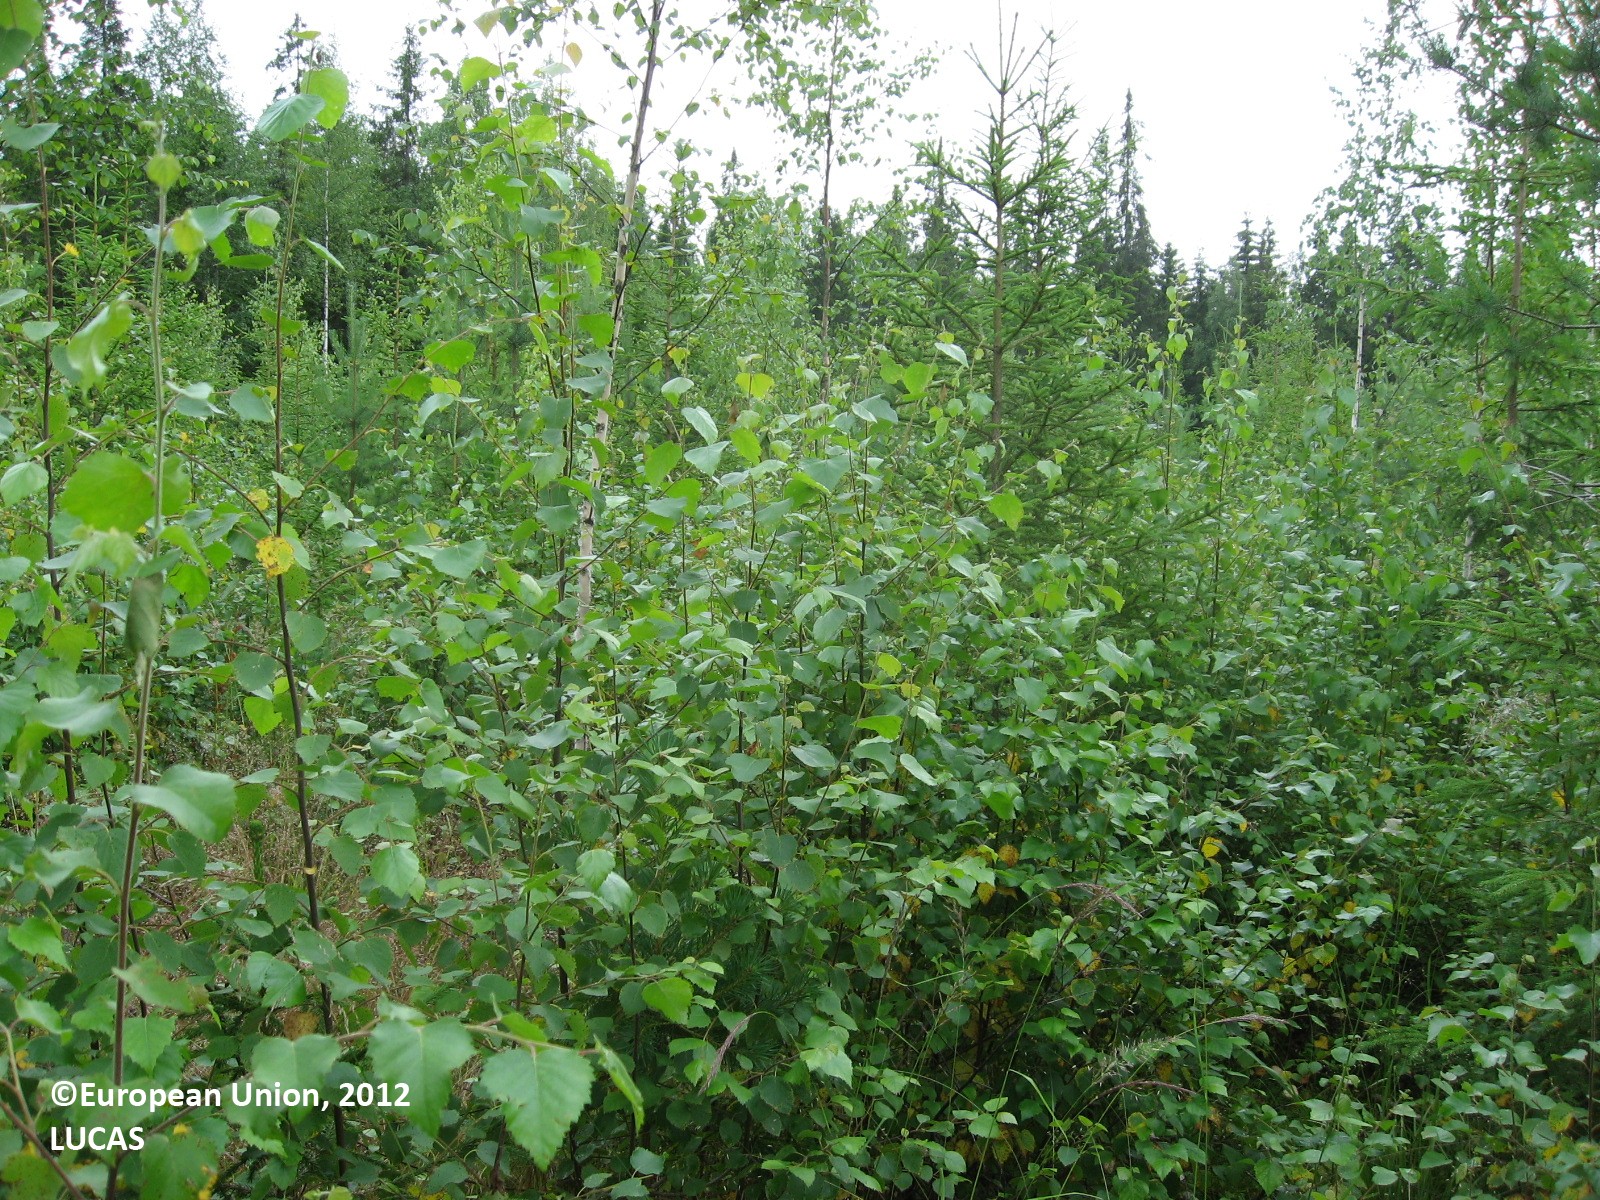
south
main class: Woodland
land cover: Spruce dominated mixed woodland
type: boreal forest
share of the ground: > 75 %
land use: Forestry
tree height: < 5 m
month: July
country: FI
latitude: 61.3844
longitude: 25.9497
